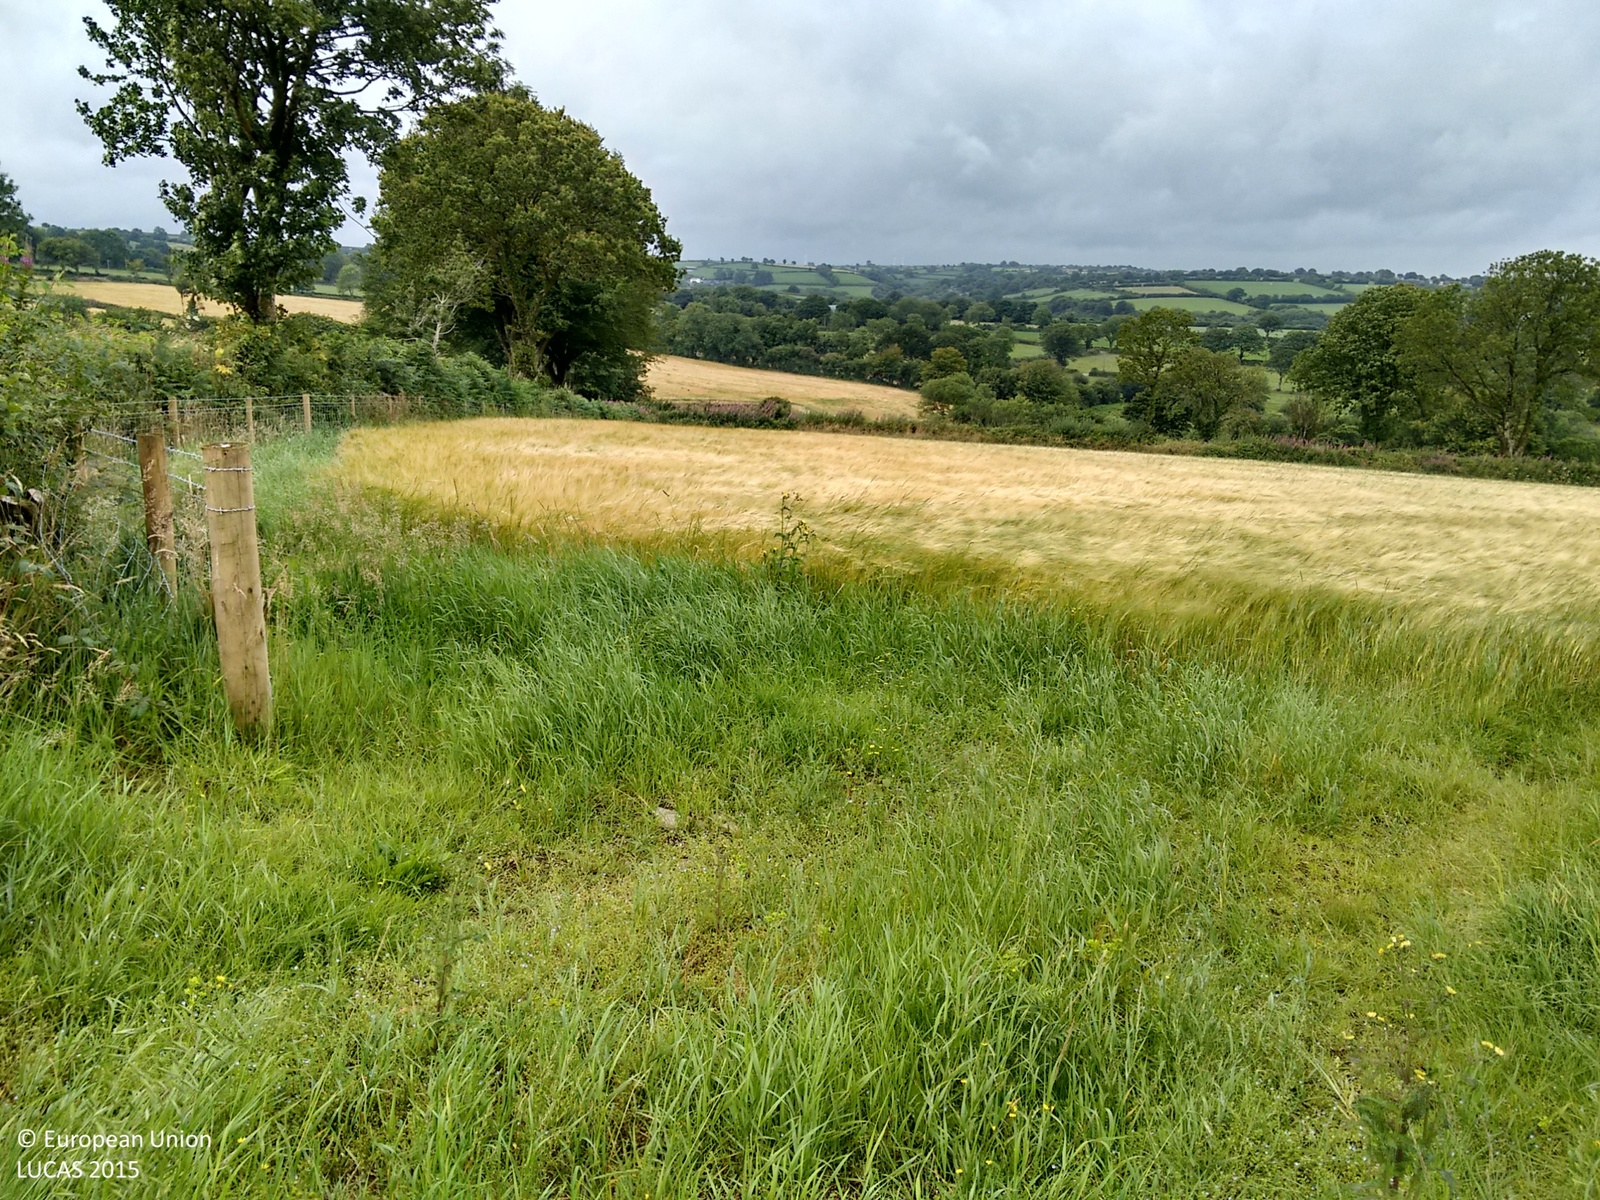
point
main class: Cropland
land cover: Barley
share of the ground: > 75 %
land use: Agriculture (excluding fallow land and kitchen gardens)
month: August
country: GB
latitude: 51.9739
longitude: -4.5028
